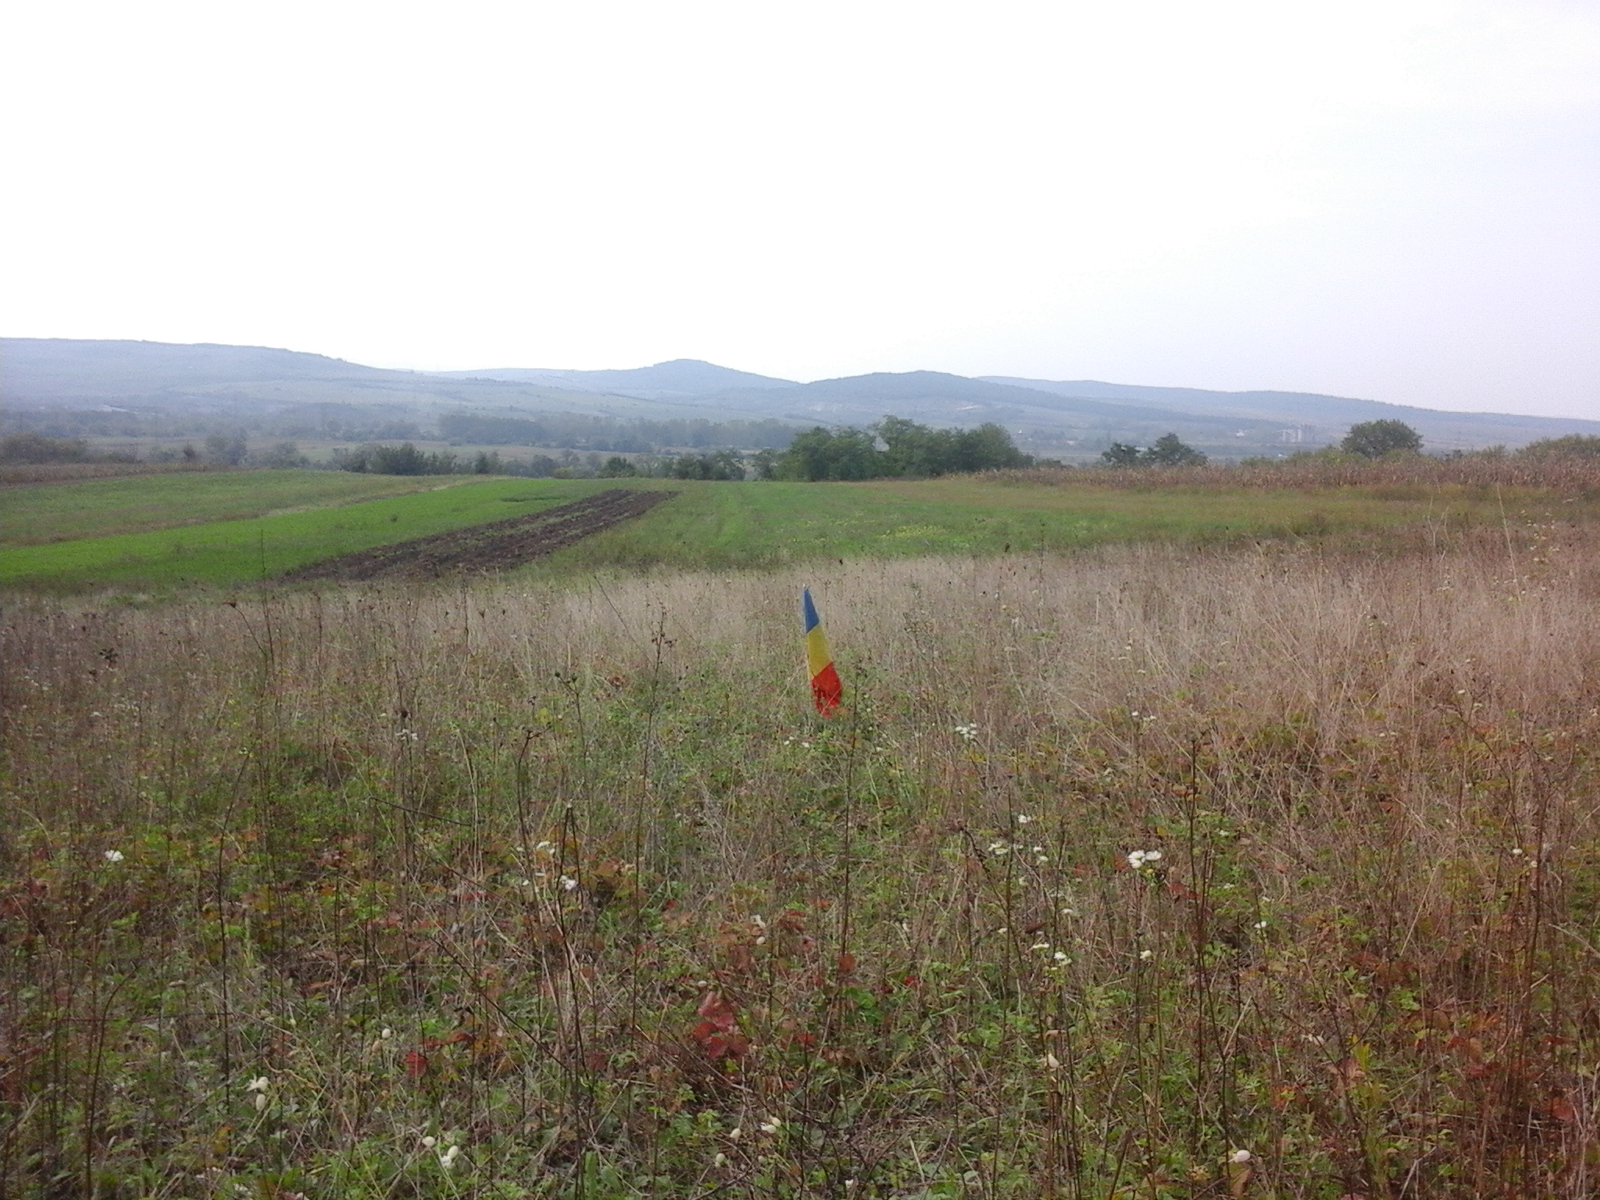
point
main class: Grassland
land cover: Spontaneously vegetated surfaces
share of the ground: > 75 %
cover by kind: herbaceous plants 100 %
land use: Agriculture (excluding fallow land and kitchen gardens)
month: September
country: RO
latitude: 45.7513
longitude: 23.0256
